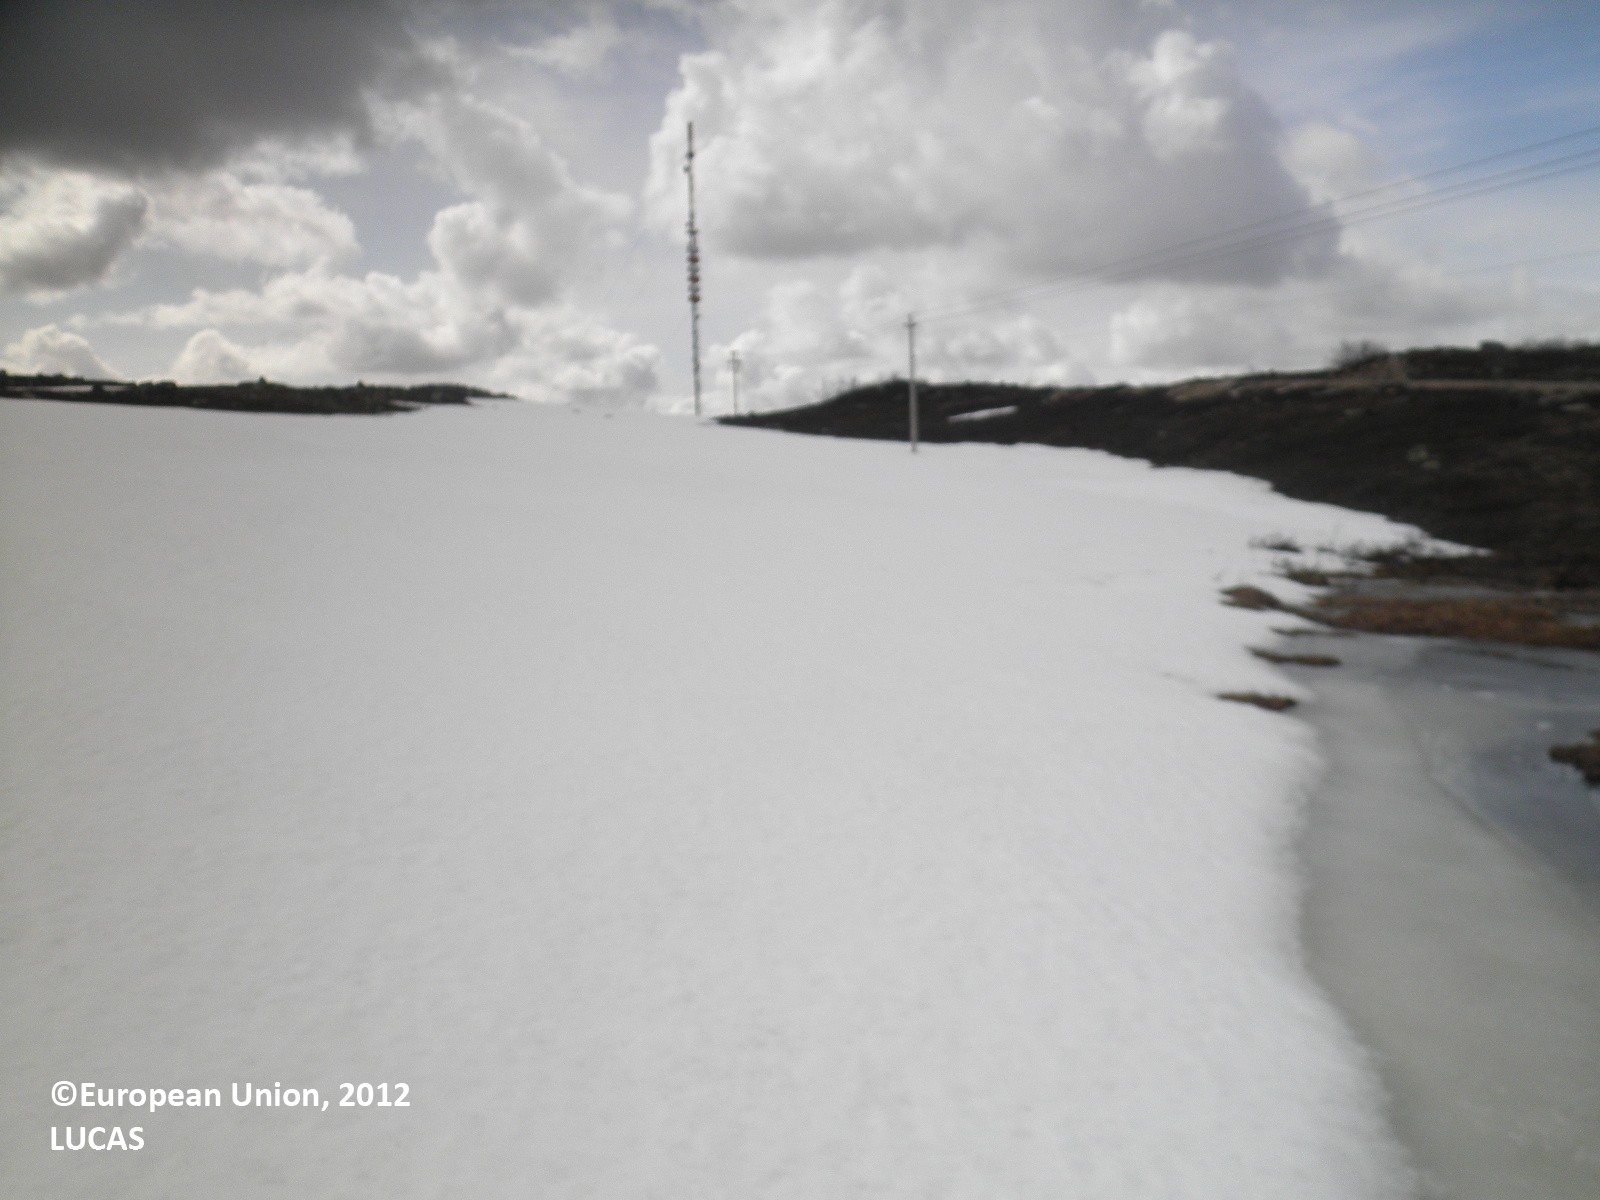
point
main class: Shrubland
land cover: Shrubland without tree cover
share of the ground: > 75 %
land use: Semi-natural and natural areas not in use
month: May
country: FI
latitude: 69.8993
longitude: 27.0673
